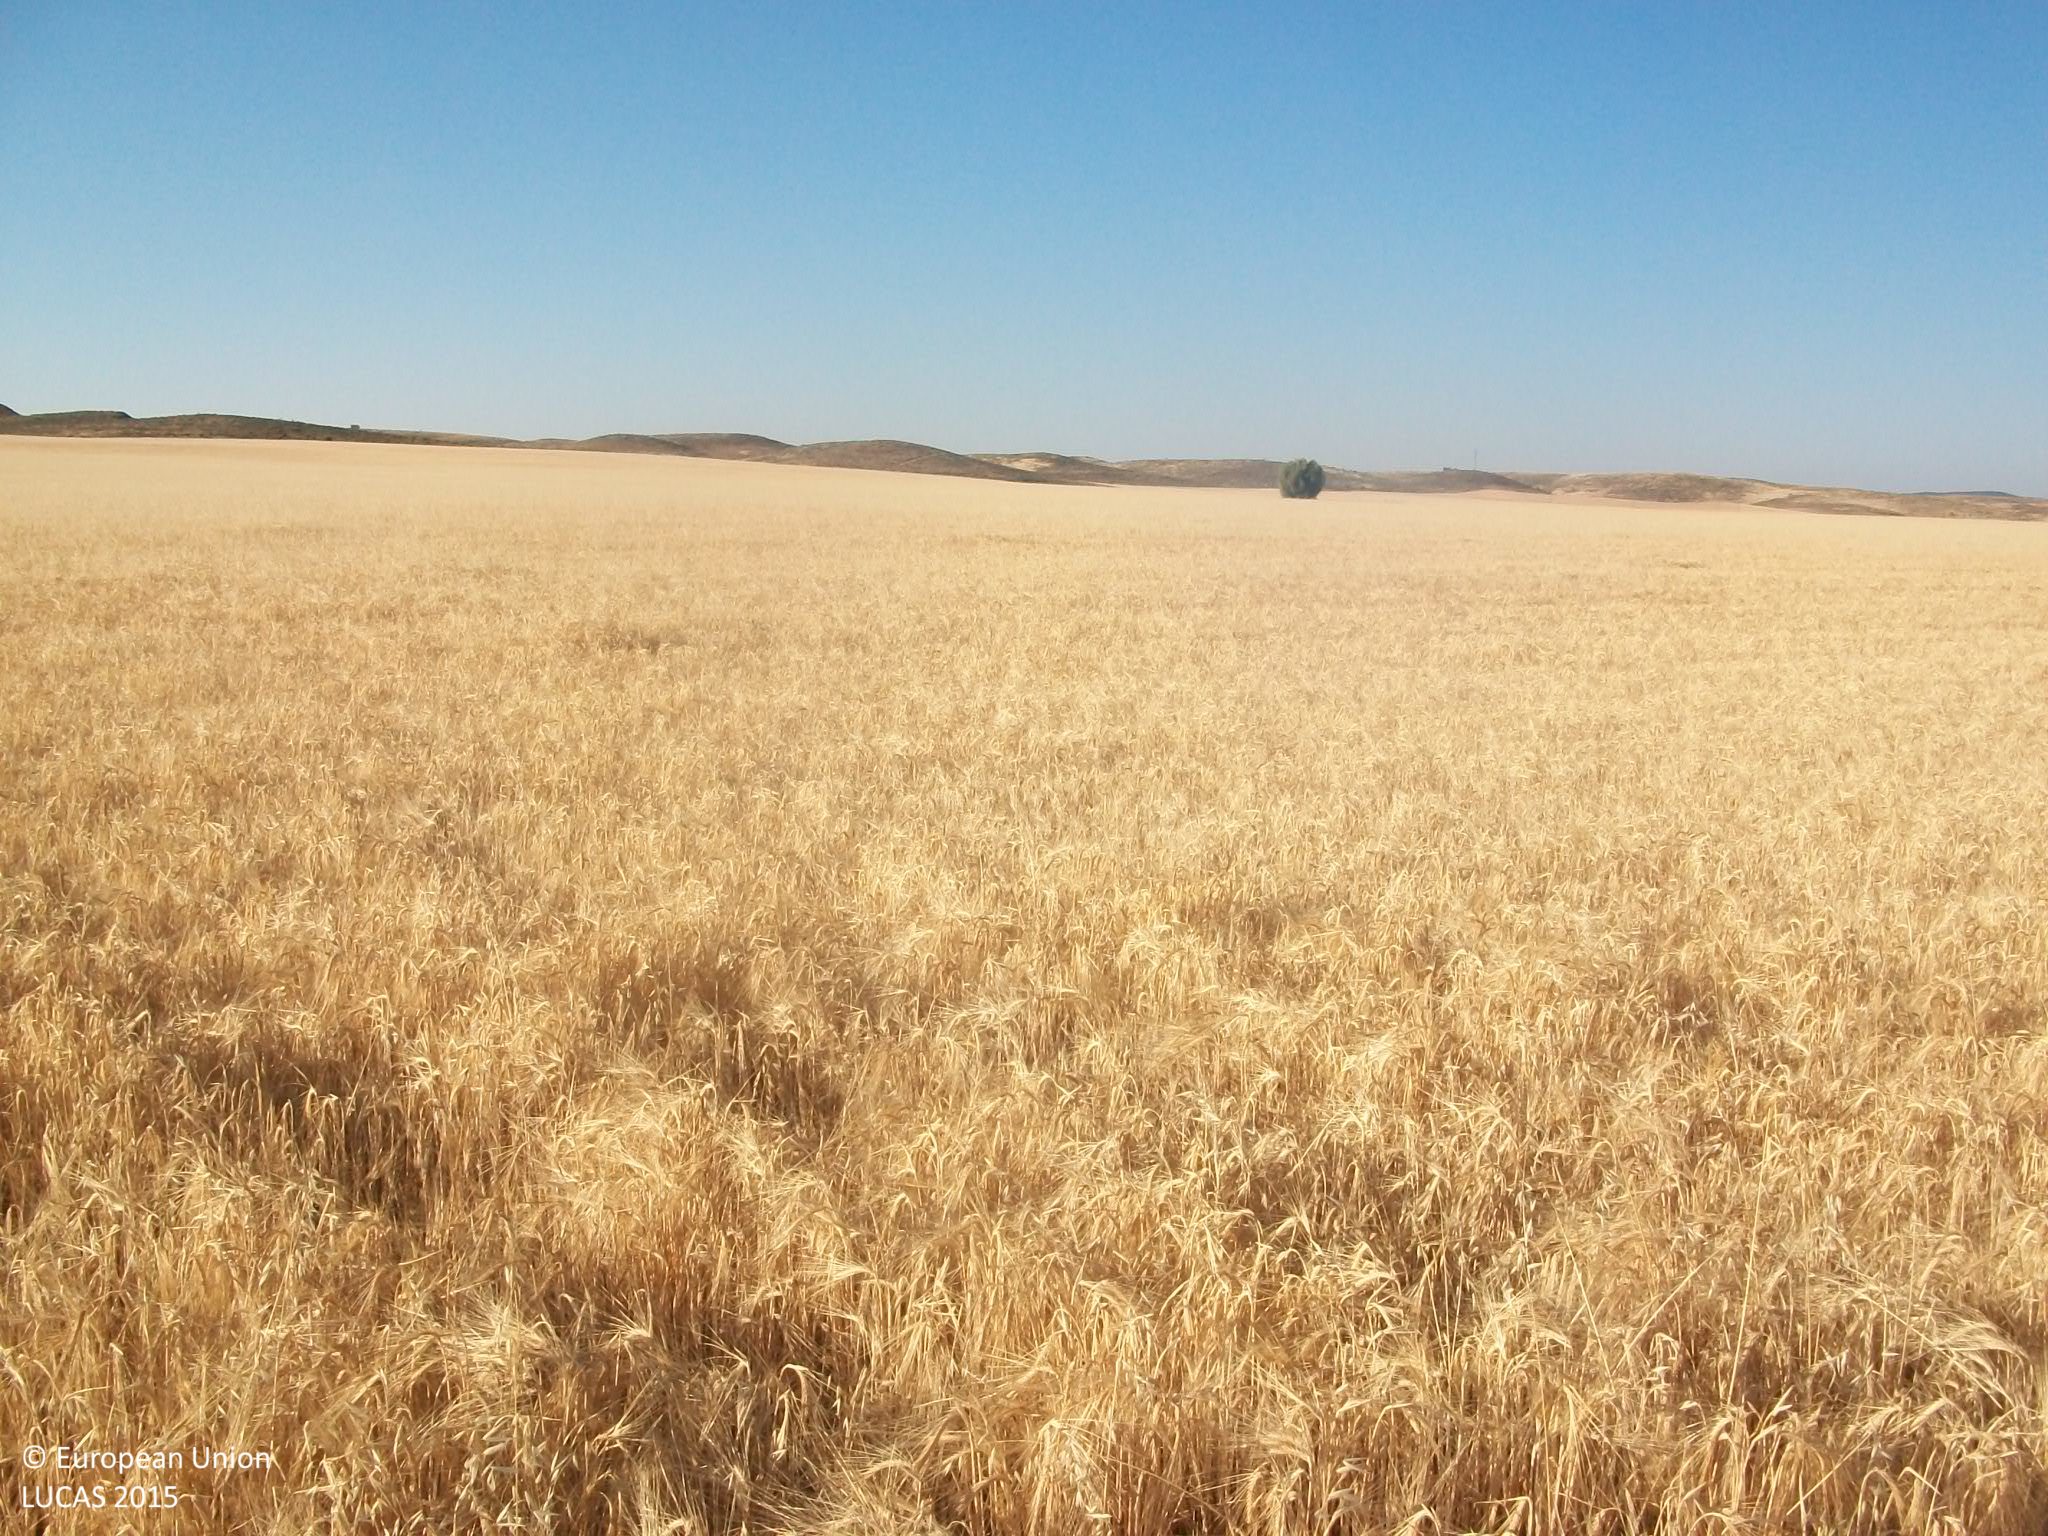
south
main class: Cropland
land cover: Barley
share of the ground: > 75 %
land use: Agriculture (excluding fallow land and kitchen gardens)
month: May
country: ES
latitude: 40.0006
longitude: -3.6778
